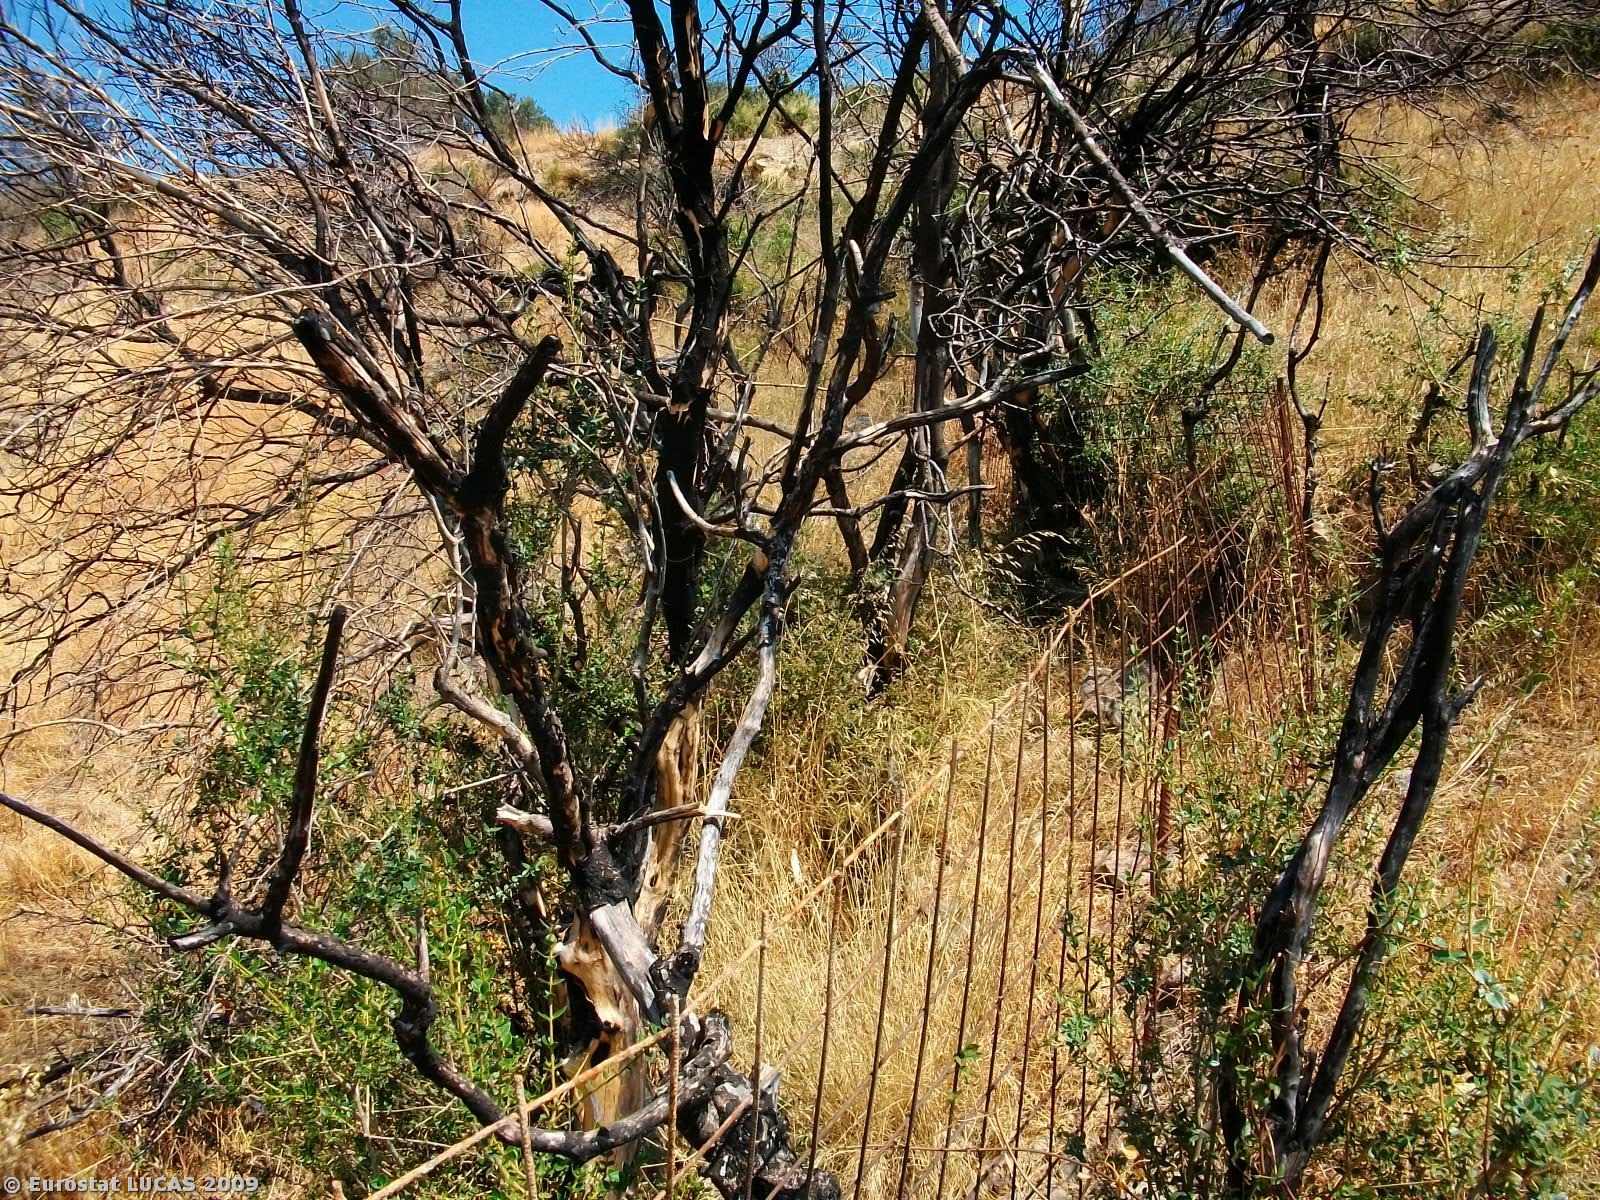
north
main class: Grassland
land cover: Grassland with sparse tree/shrub cover
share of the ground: > 75 %
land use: Unused
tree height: < 5 m
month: August
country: GR
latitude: 38.4925
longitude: 23.9668
